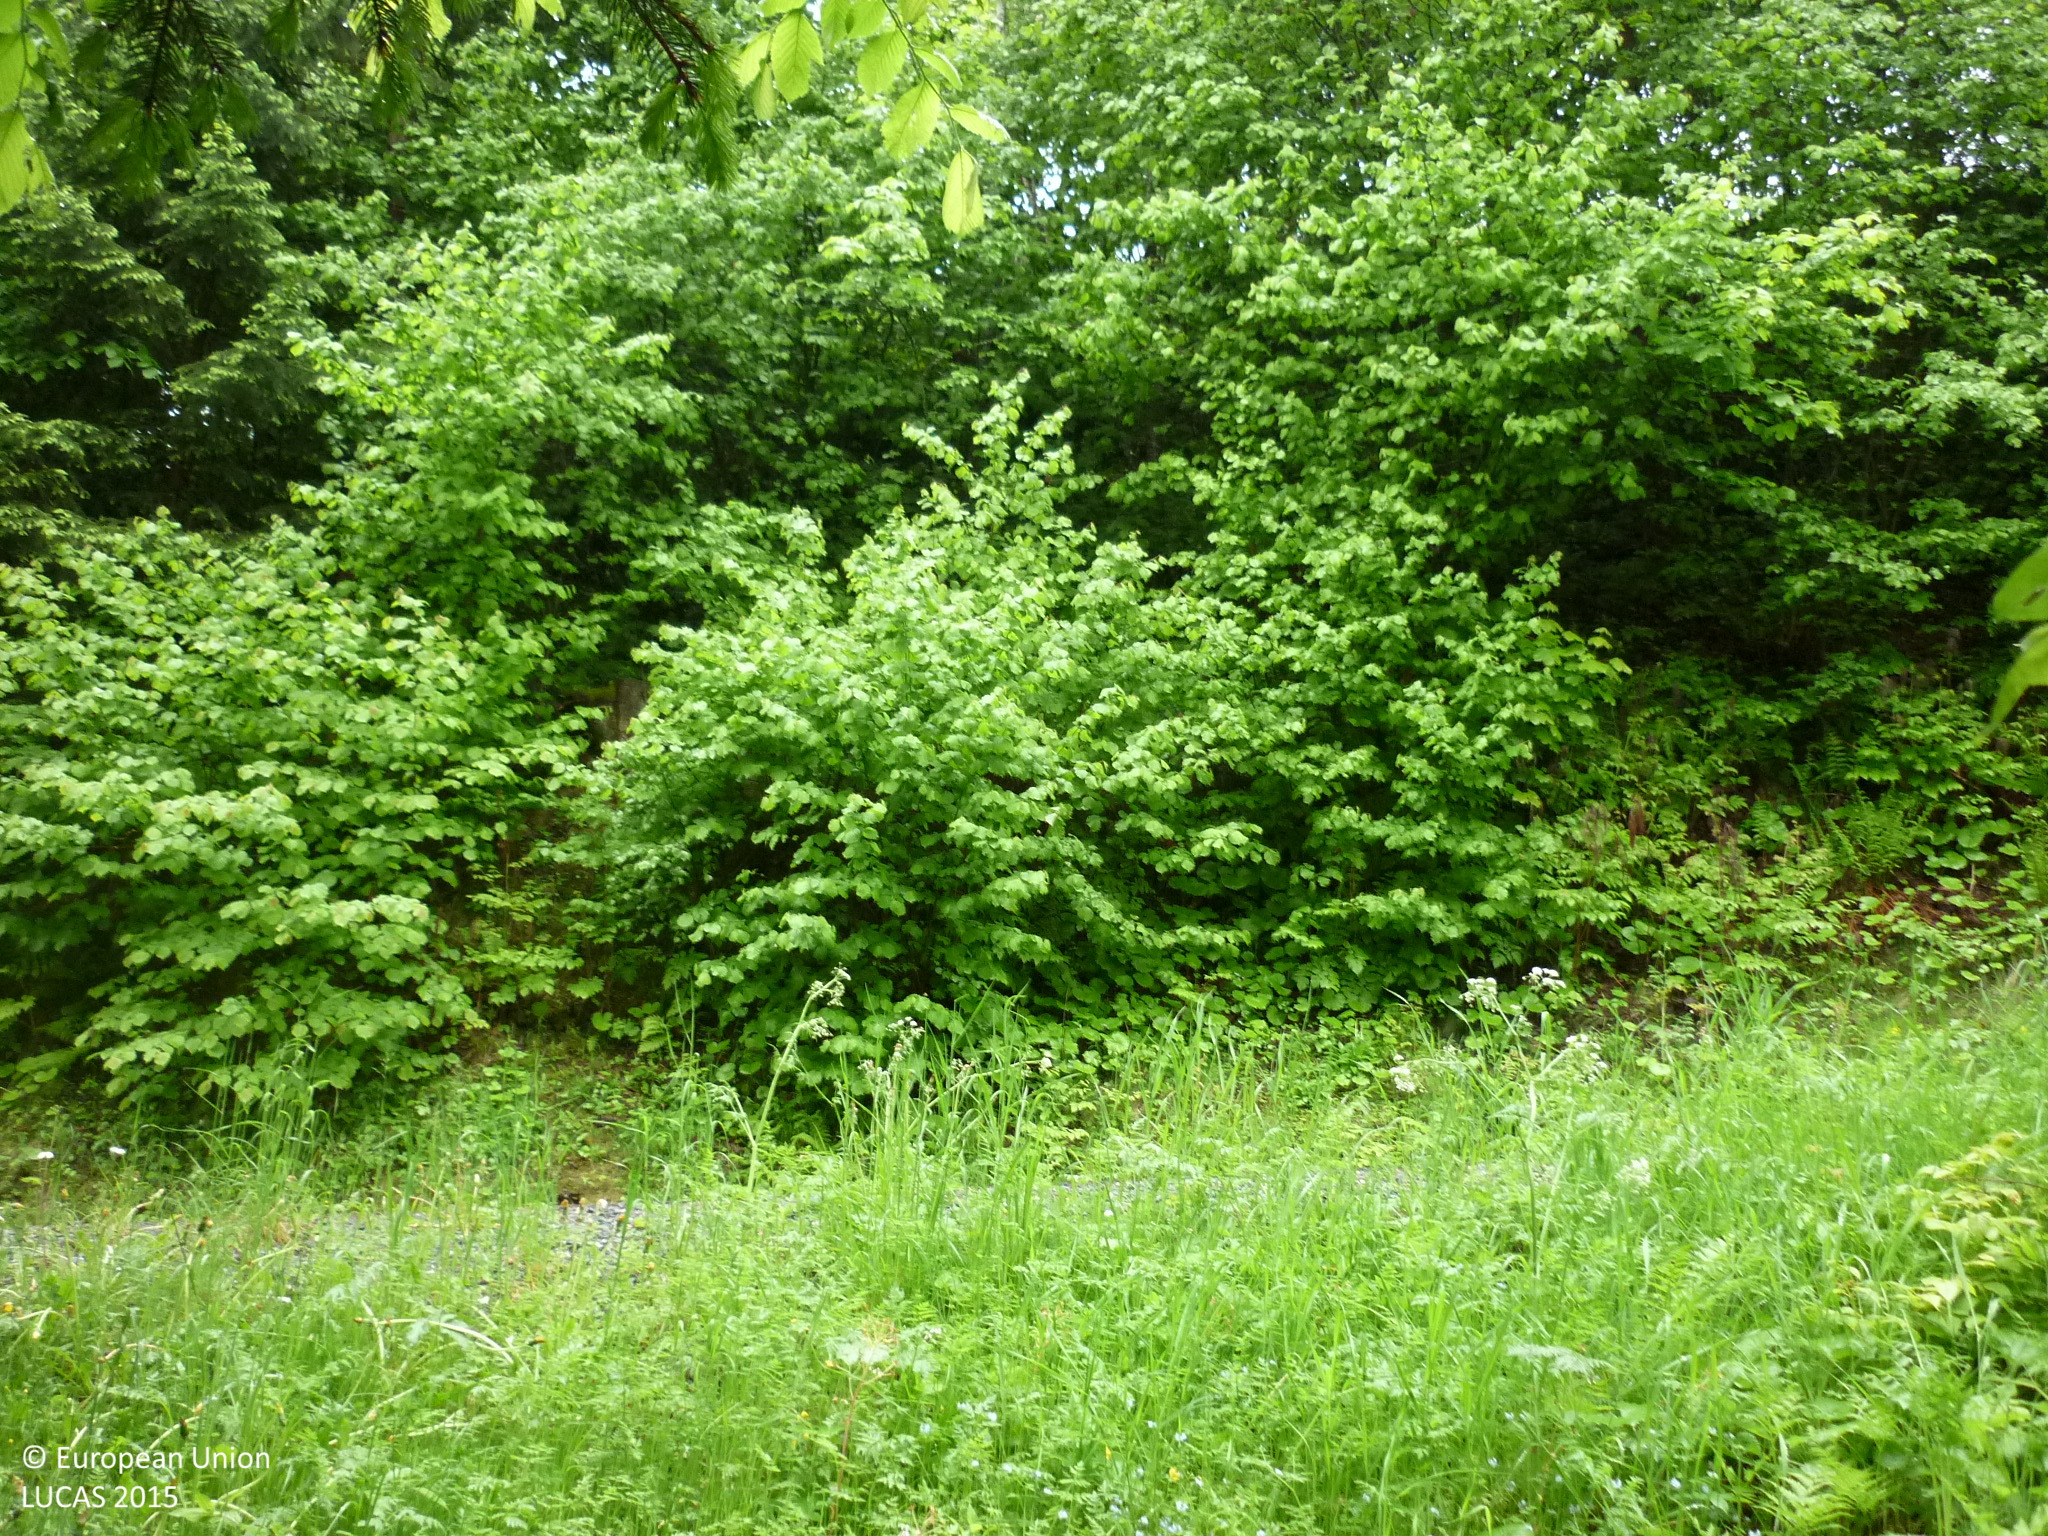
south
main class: Woodland
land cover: Spruce dominated mixed woodland
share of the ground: > 75 %
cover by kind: coniferous forest trees 45 %, broadleaved forest trees 30 %, herbaceous plants 25 %
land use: Forestry
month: May
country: AT
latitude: 47.1032
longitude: 14.0696
